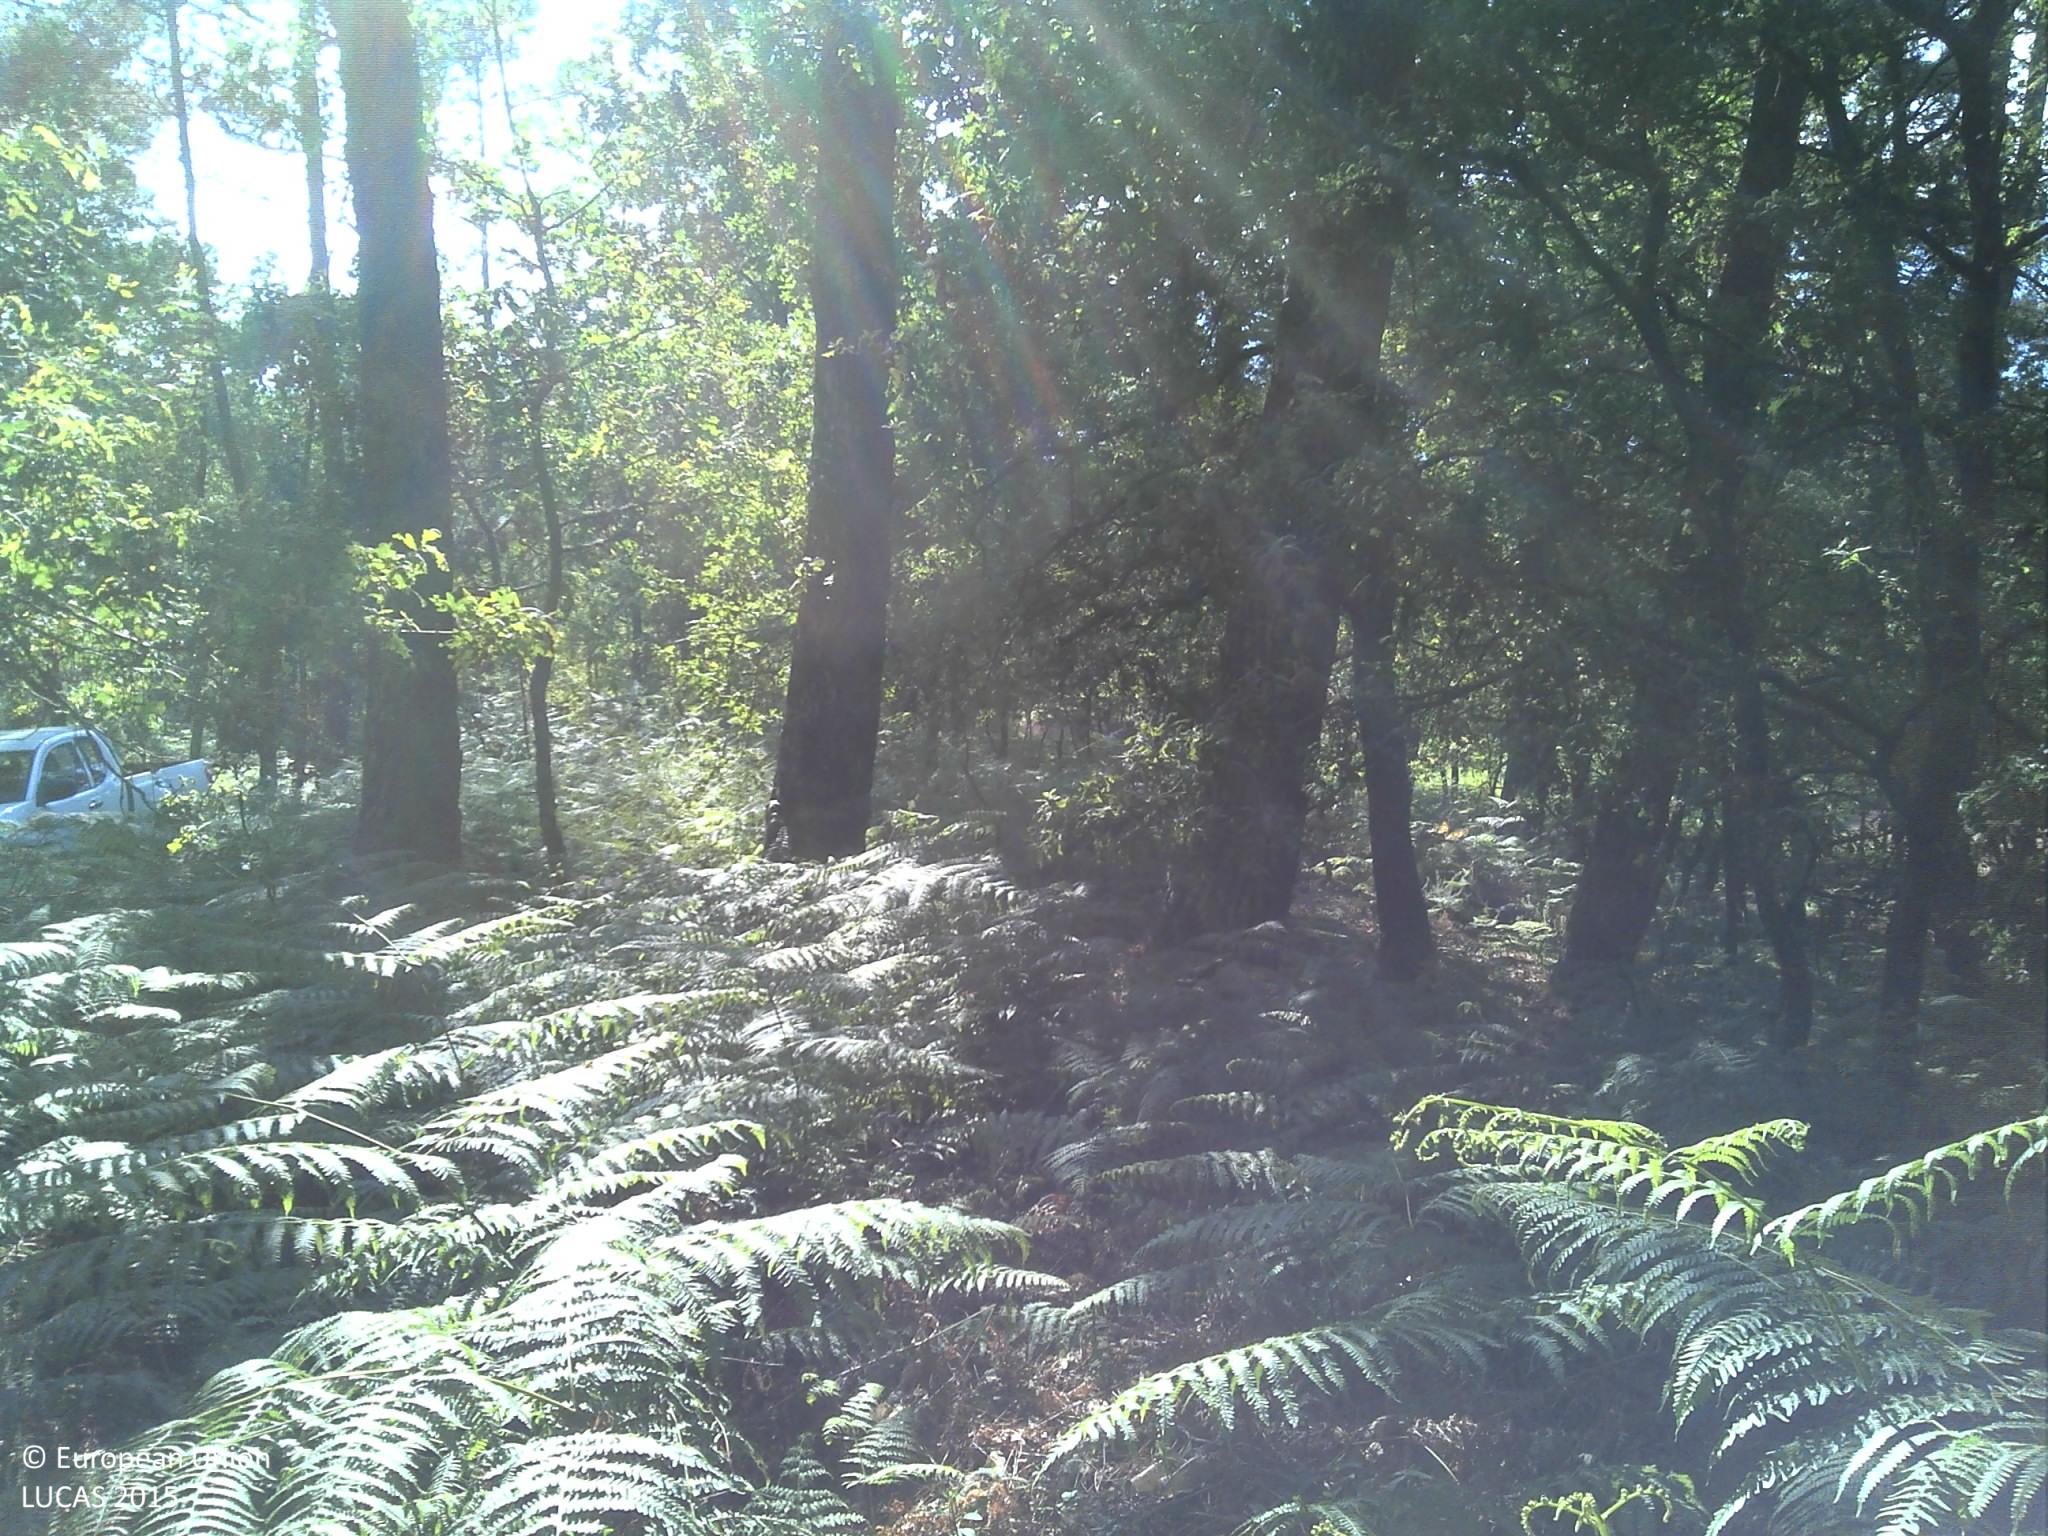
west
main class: Woodland
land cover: Broadleaved woodland
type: acidophilous oak and oak-birch forest
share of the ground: > 75 %
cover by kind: broadleaved forest trees 85 %, coniferous forest trees 5 %, herbaceous plants 5 %, unconsolidated bare surface 5 %
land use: Forestry
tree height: > 5 m
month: June
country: PT
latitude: 42.0864
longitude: -8.2549
